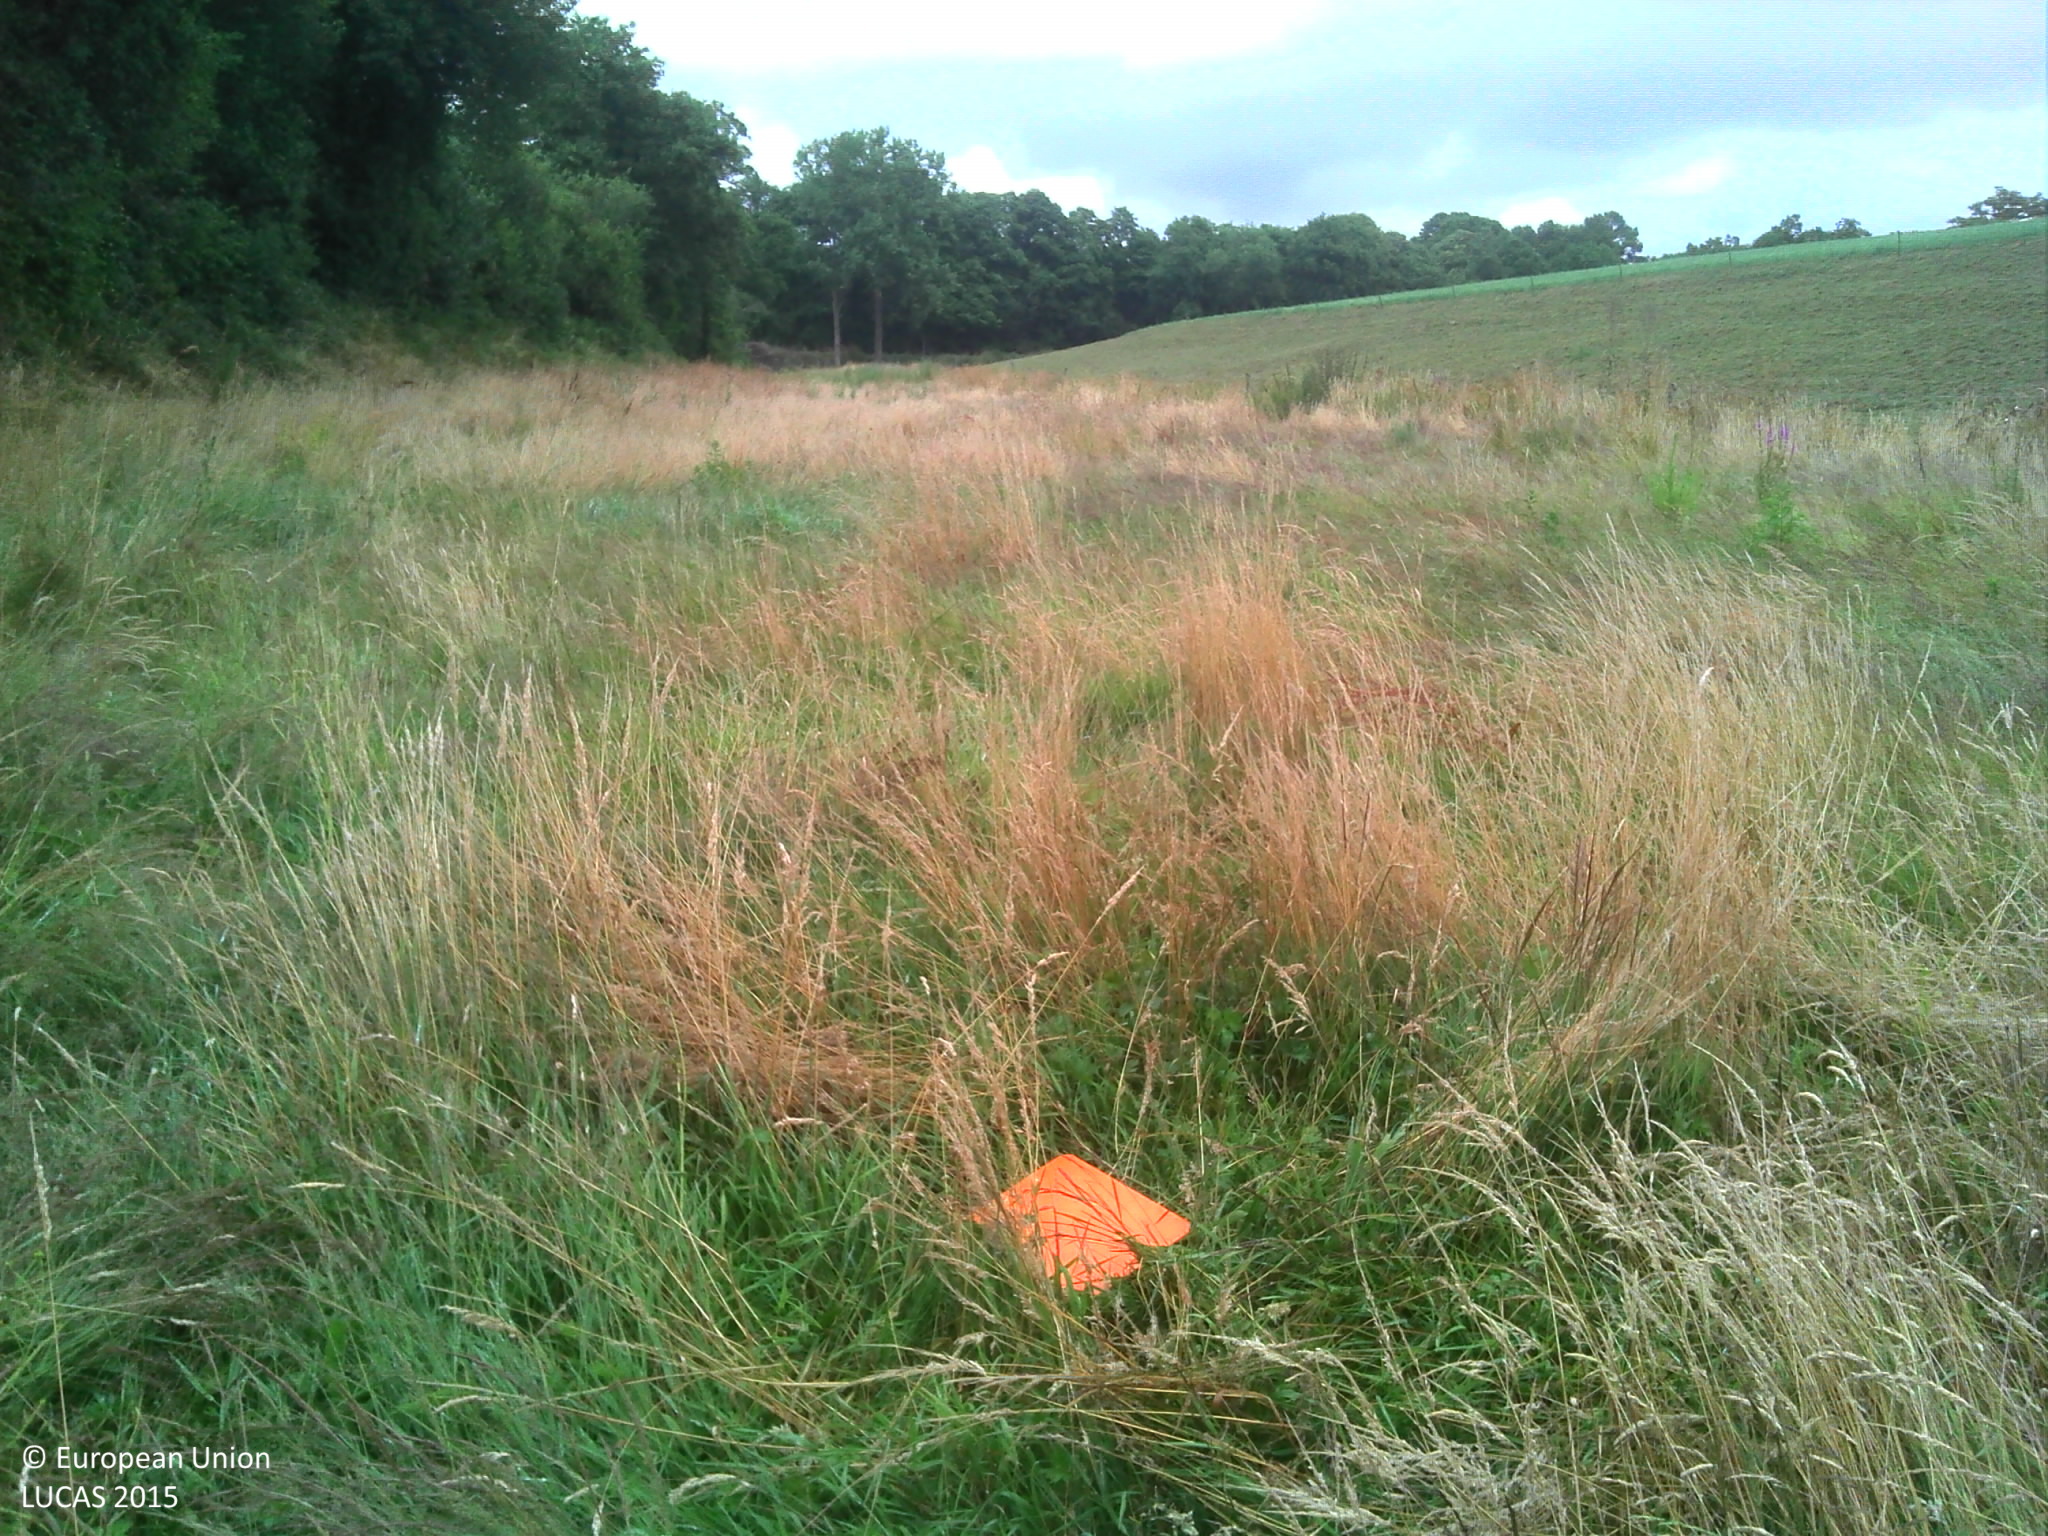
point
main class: Grassland
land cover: Grassland without tree/shrub cover
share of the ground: > 75 %
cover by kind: herbaceous plants 100 %
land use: Agriculture (excluding fallow land and kitchen gardens)
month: July
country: FR
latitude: 46.5385
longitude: -1.5789
